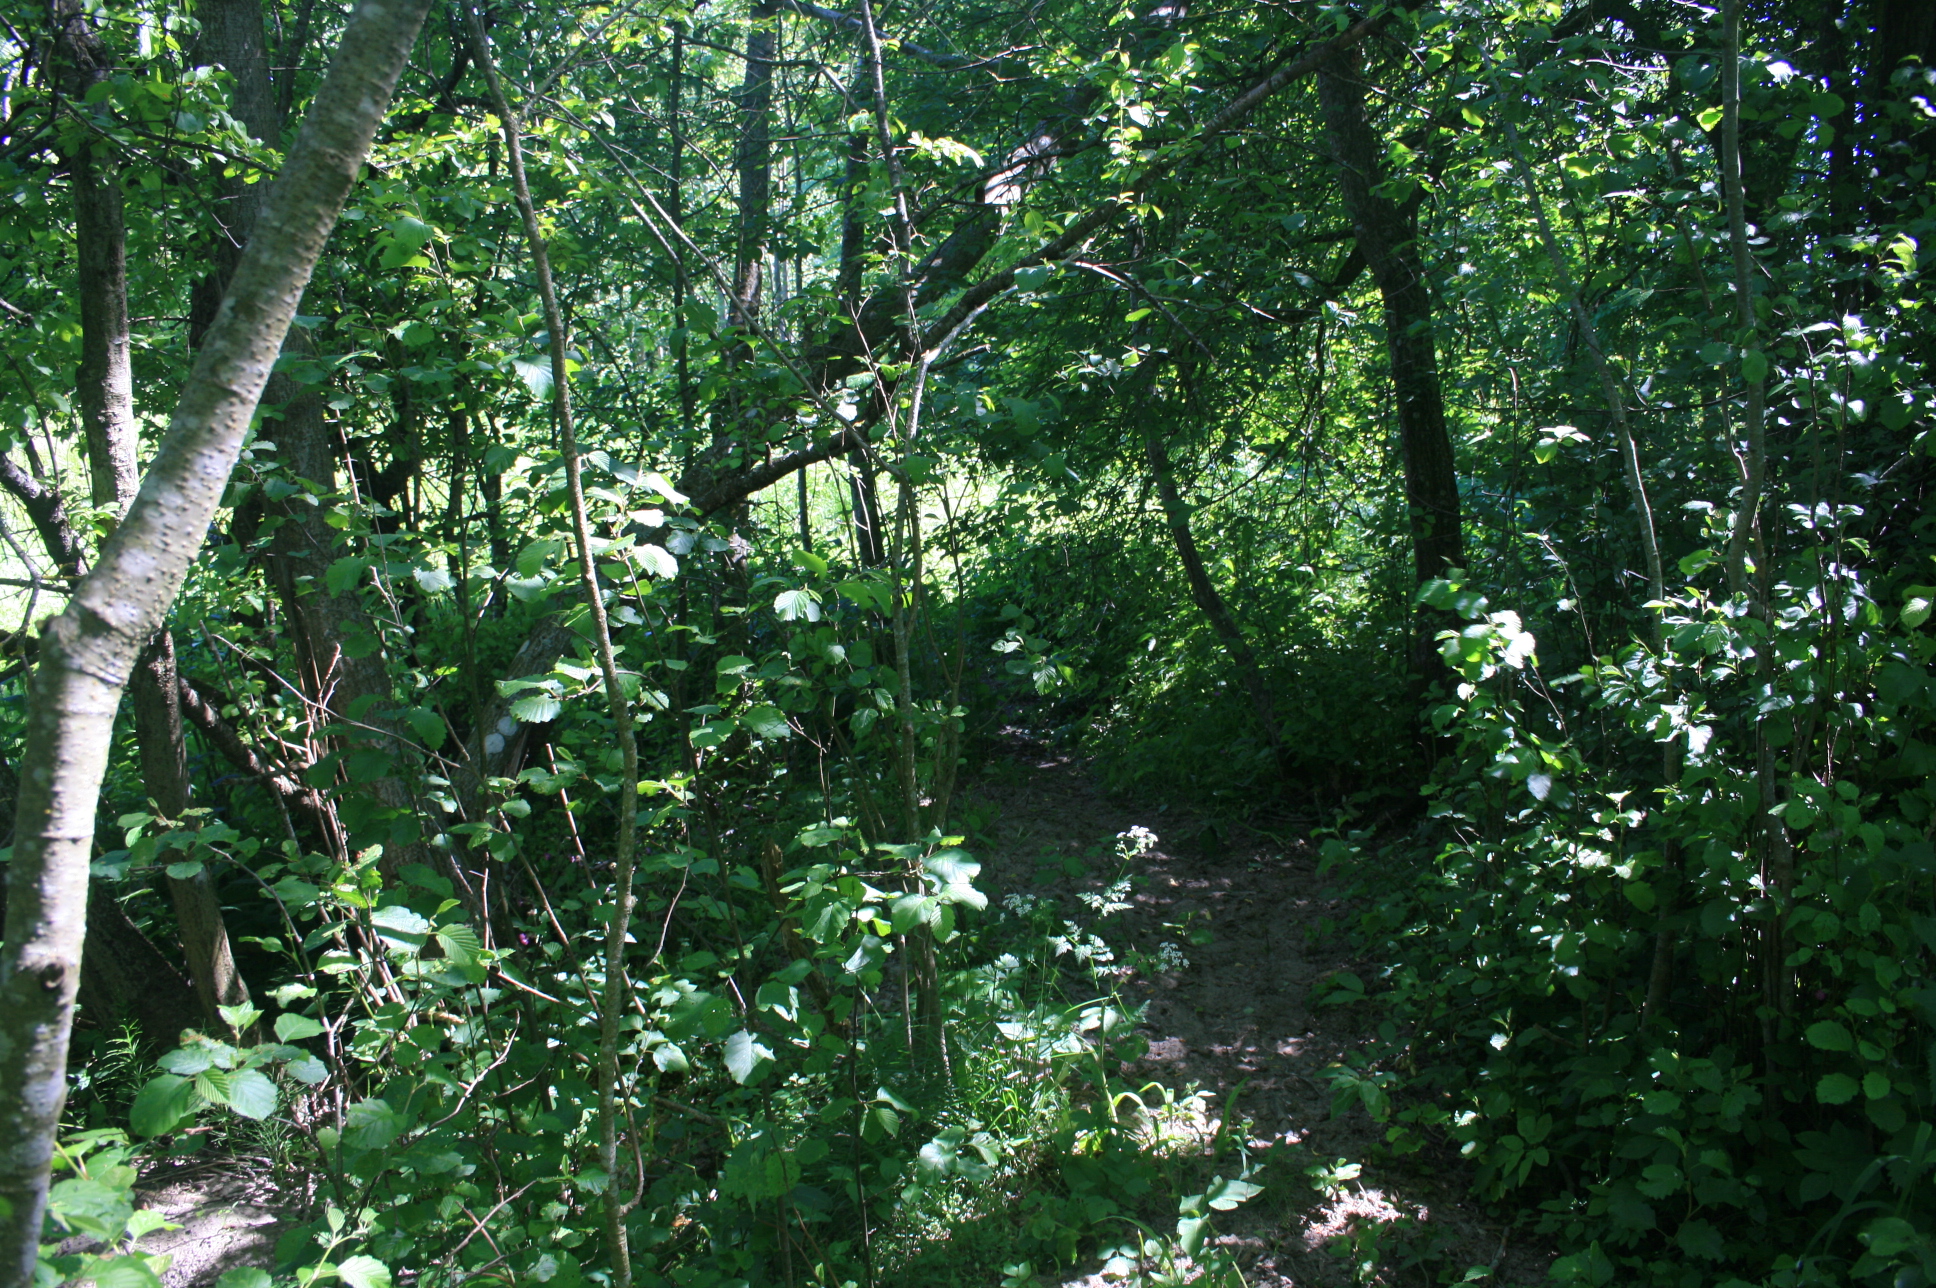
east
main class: Woodland
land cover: Broadleaved woodland
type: floodplain forest
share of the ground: > 75 %
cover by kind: broadleaved forest trees 90 %, herbaceous plants 5 %, unconsolidated bare surface 5 %
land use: Semi-natural and natural areas not in use
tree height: > 5 m
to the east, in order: Broadleaved woodland; Ditches and canals; Broadleaved woodland; Grassland without tree/shrub cover; Artificial constructions in urban areas; Grassland without tree/shrub cover; Electric lines; Tracks; Grassland without tree/shrub cover
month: June
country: LT
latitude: 55.5532
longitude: 22.1503
